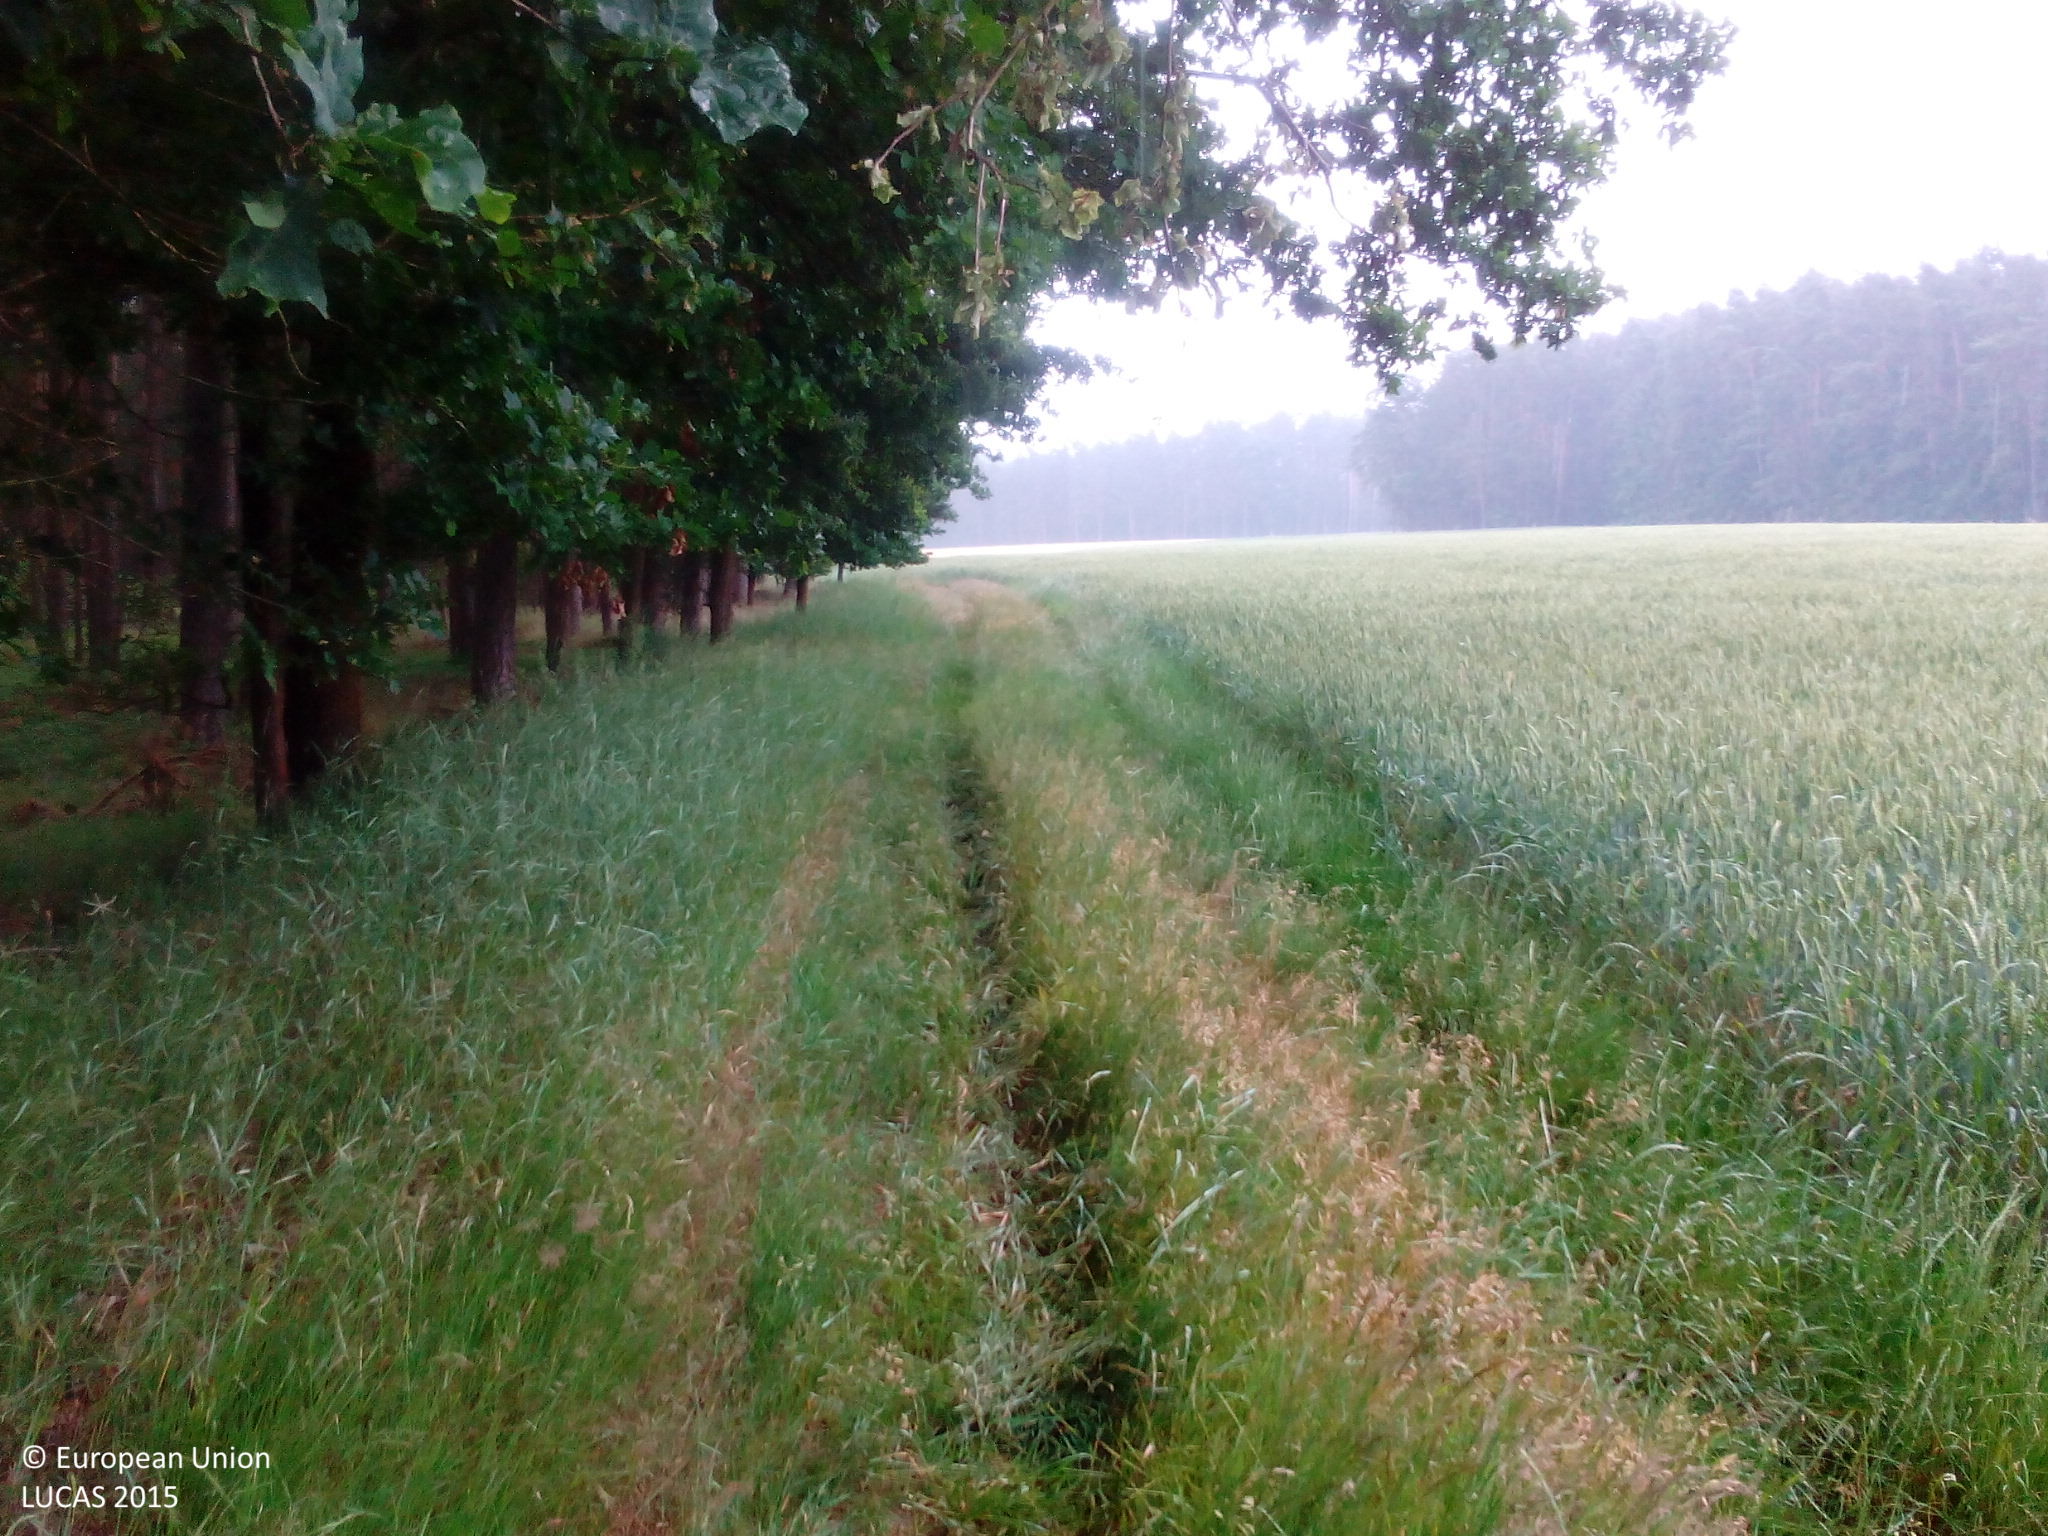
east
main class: Woodland
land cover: Pine dominated coniferous woodland
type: hemiboreal forest and nemoral coniferous forest and mixed broadleaved-coniferous forest
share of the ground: > 75 %
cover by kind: coniferous forest trees 75 %, herbaceous plants 20 %, broadleaved forest trees 5 %
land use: Forestry
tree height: > 5 m
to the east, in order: Tracks; Common wheat; Grass margins; Barley
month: June
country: DE
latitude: 49.2814
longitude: 10.8932
